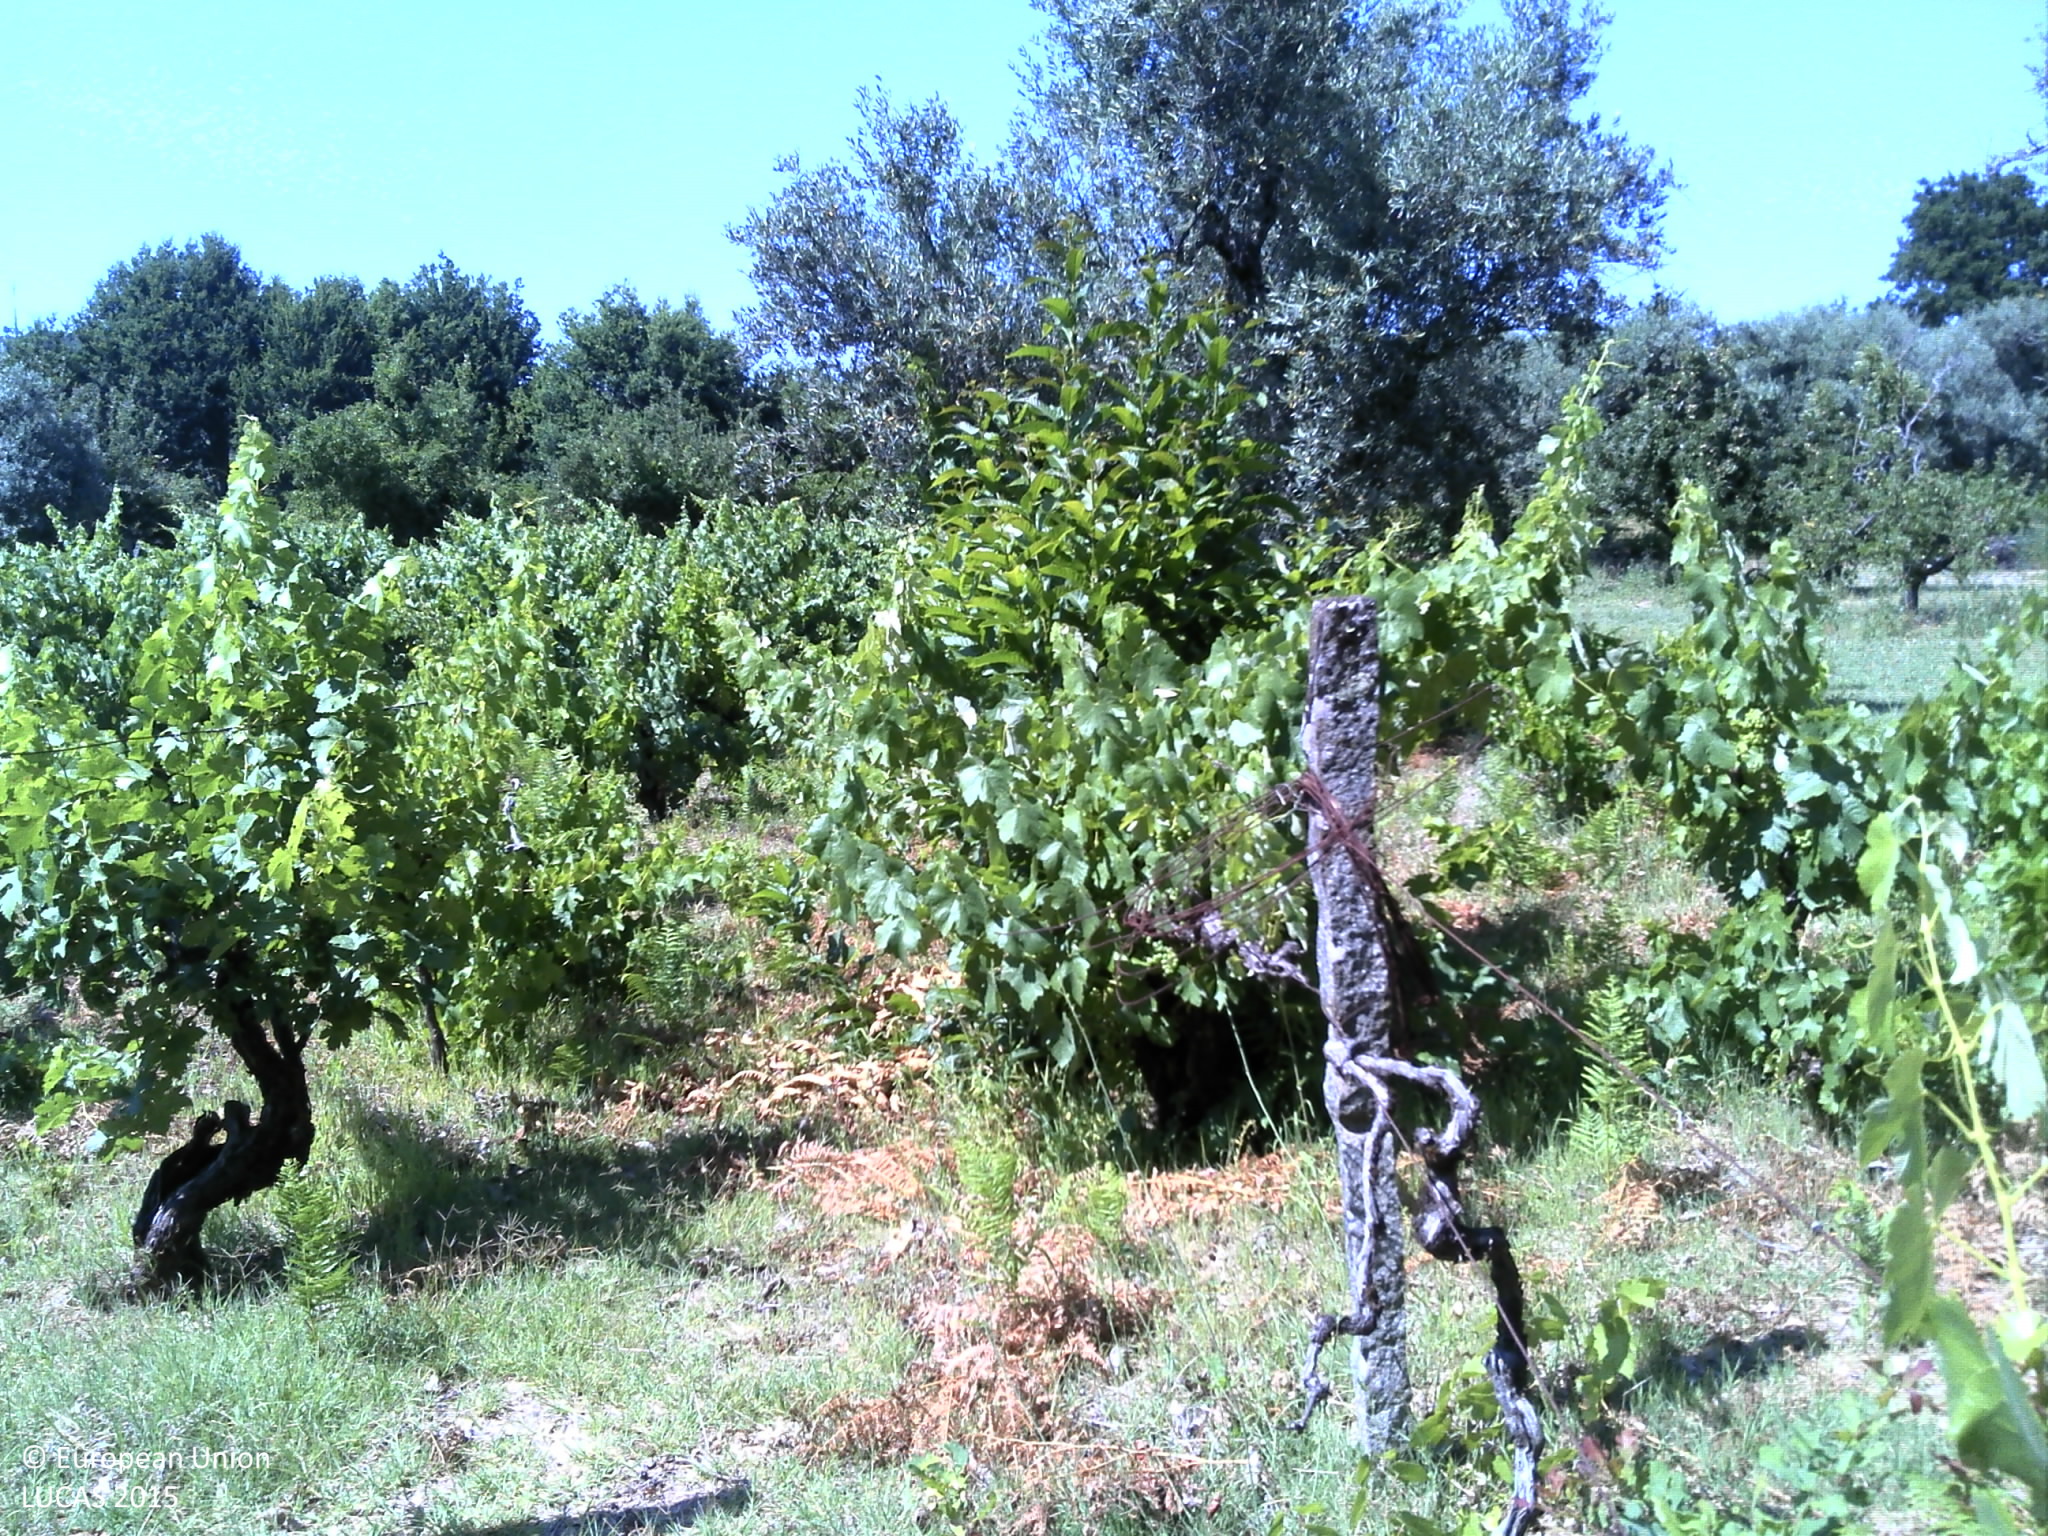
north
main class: Cropland
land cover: Vineyards
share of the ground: 10 - 25 %
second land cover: Grassland without tree/shrub cover
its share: 50 - 75 %
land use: Agriculture (excluding fallow land and kitchen gardens)
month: July
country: PT
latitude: 40.7476
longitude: -7.8053
